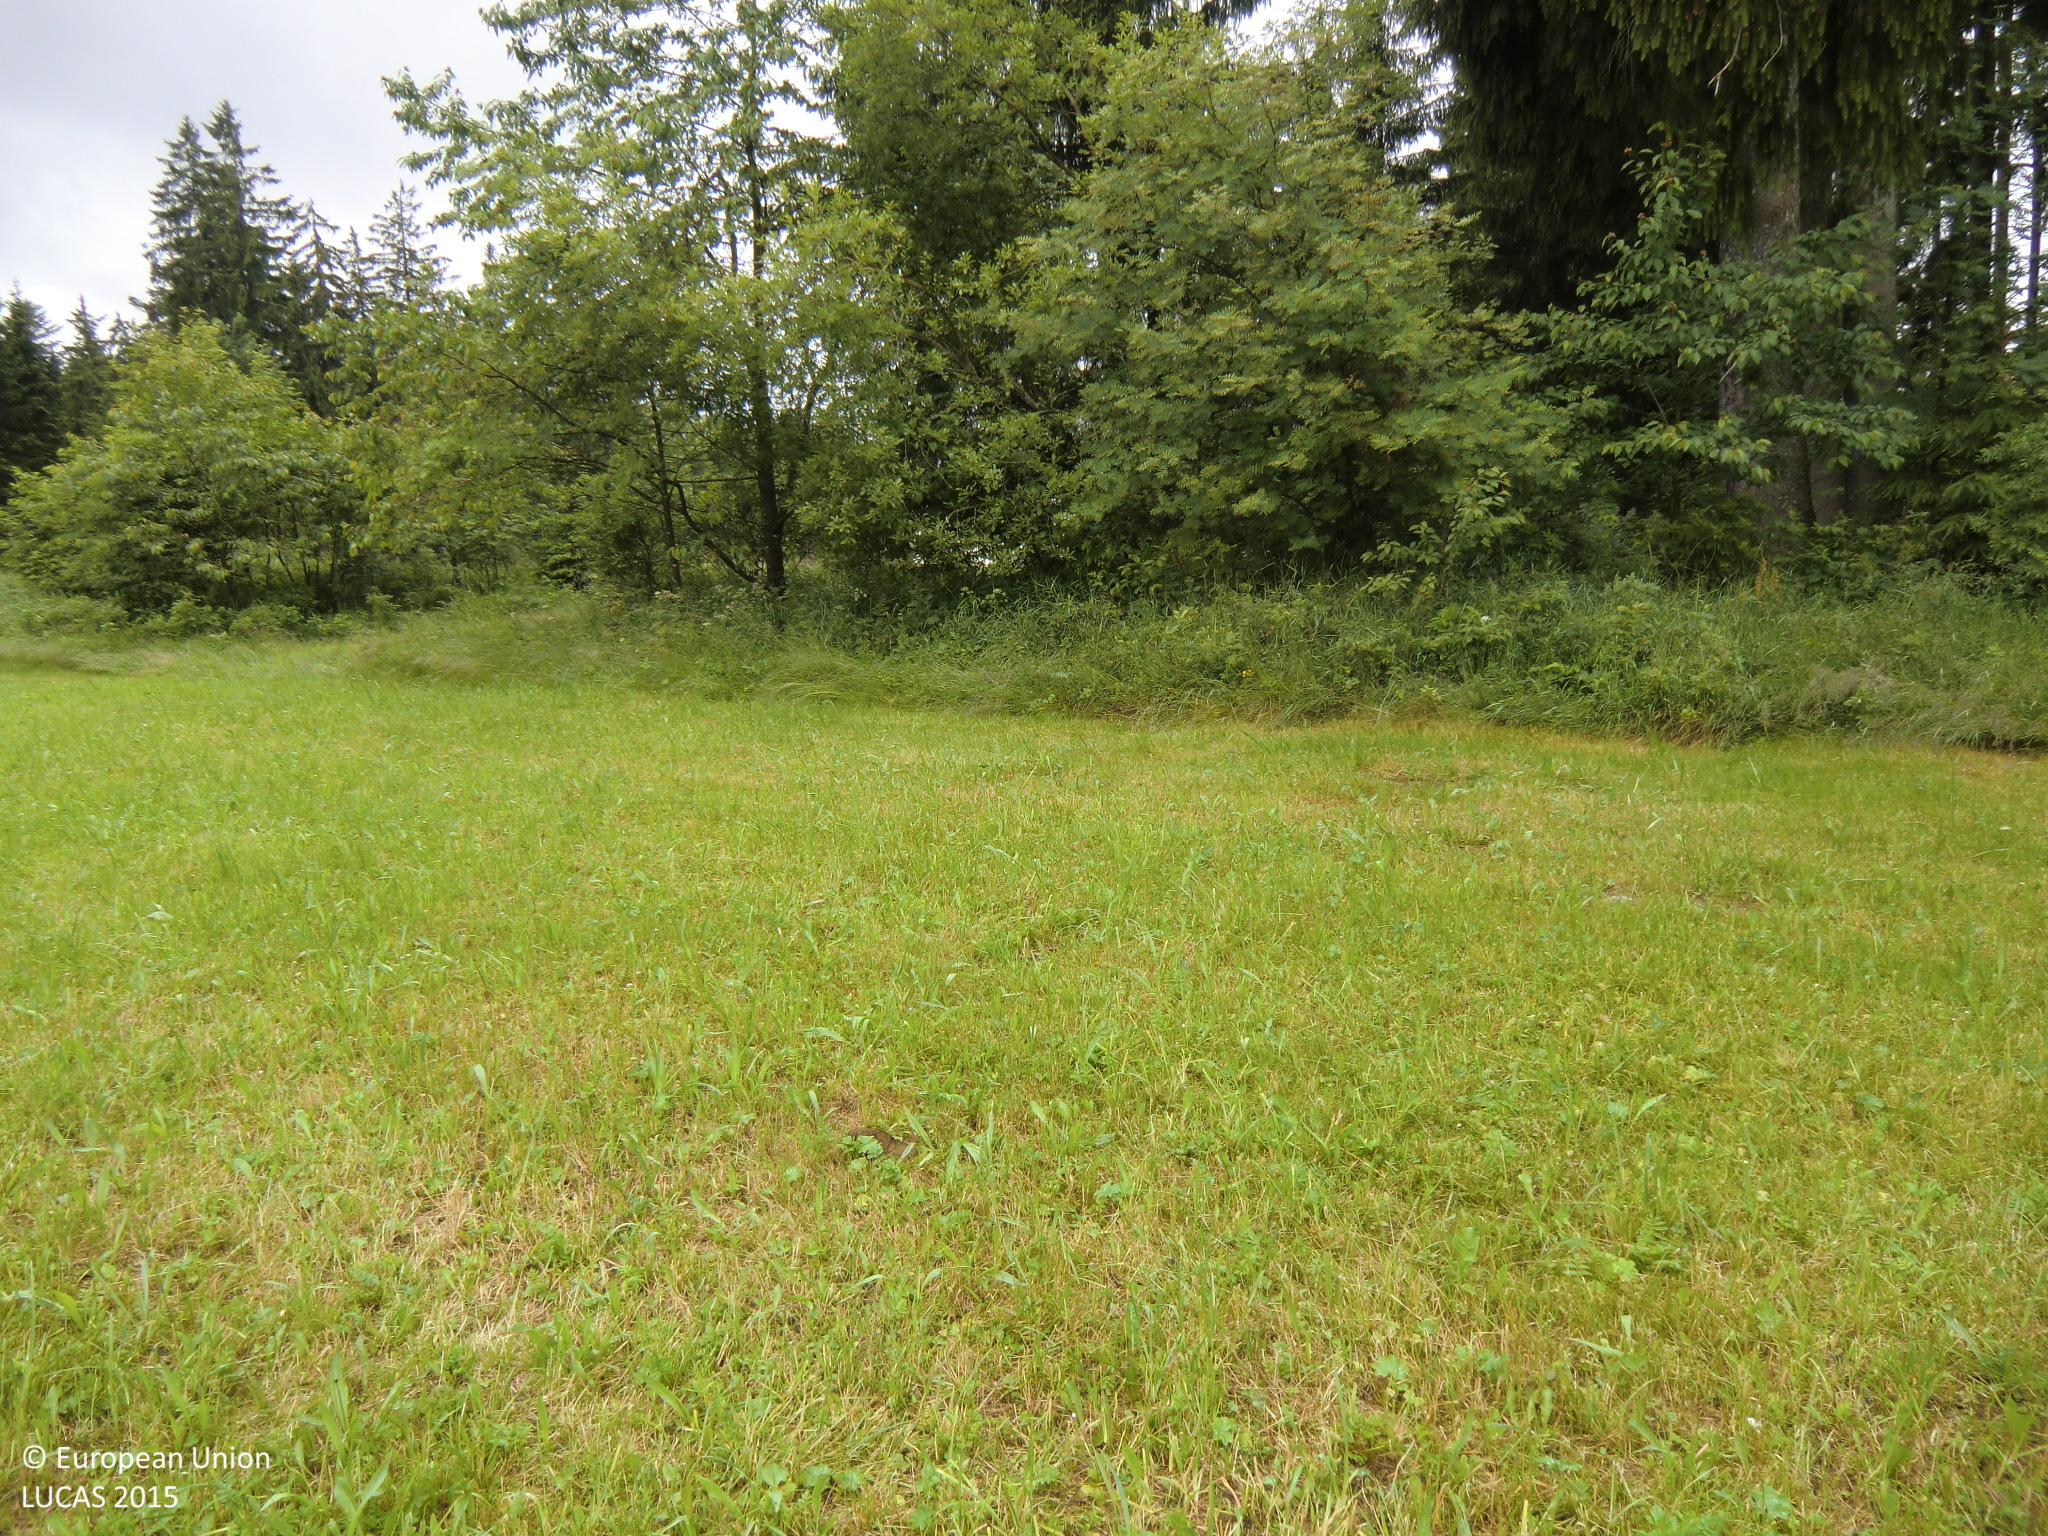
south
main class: Grassland
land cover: Grassland without tree/shrub cover
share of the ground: > 75 %
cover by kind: herbaceous plants 100 %
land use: Agriculture (excluding fallow land and kitchen gardens)
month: June
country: AT
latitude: 48.5413
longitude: 14.6197
